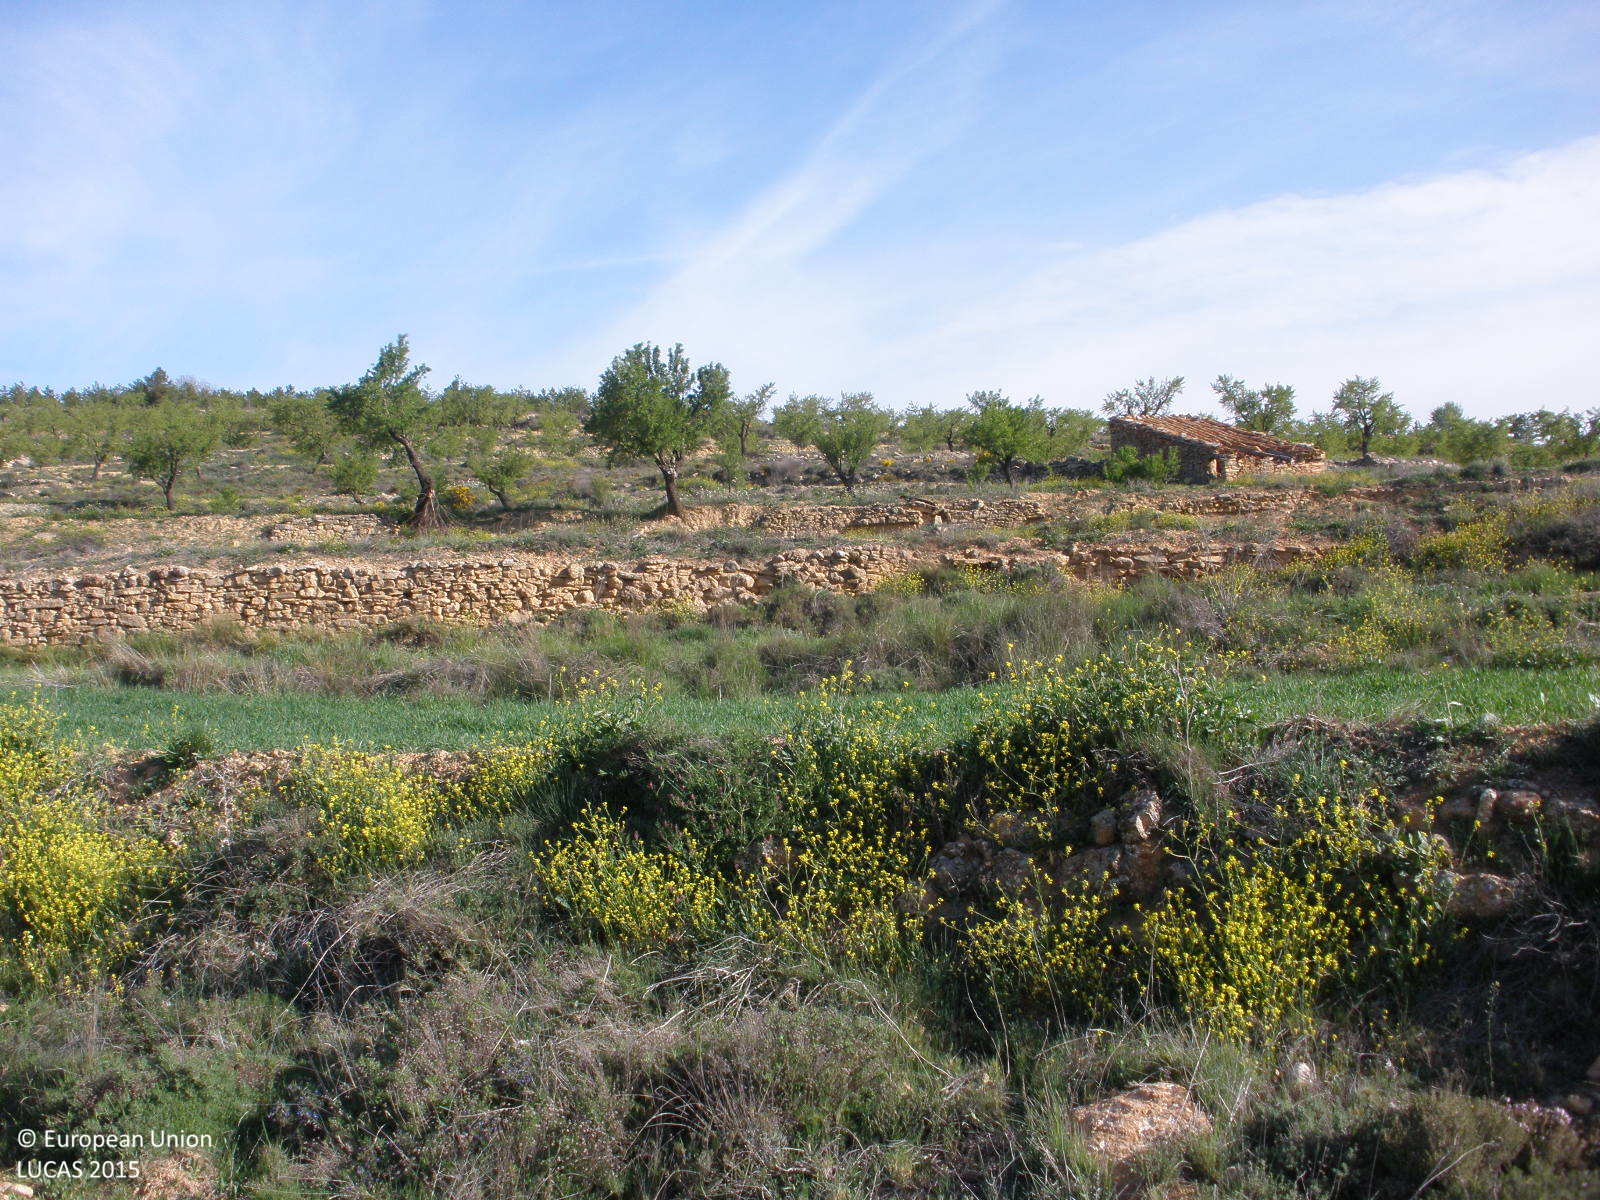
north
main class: Cropland
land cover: Barley
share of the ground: > 75 %
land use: Agriculture (excluding fallow land and kitchen gardens)
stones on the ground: 10 - 25 %
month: April
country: ES
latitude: 40.0614
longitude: -1.2045
